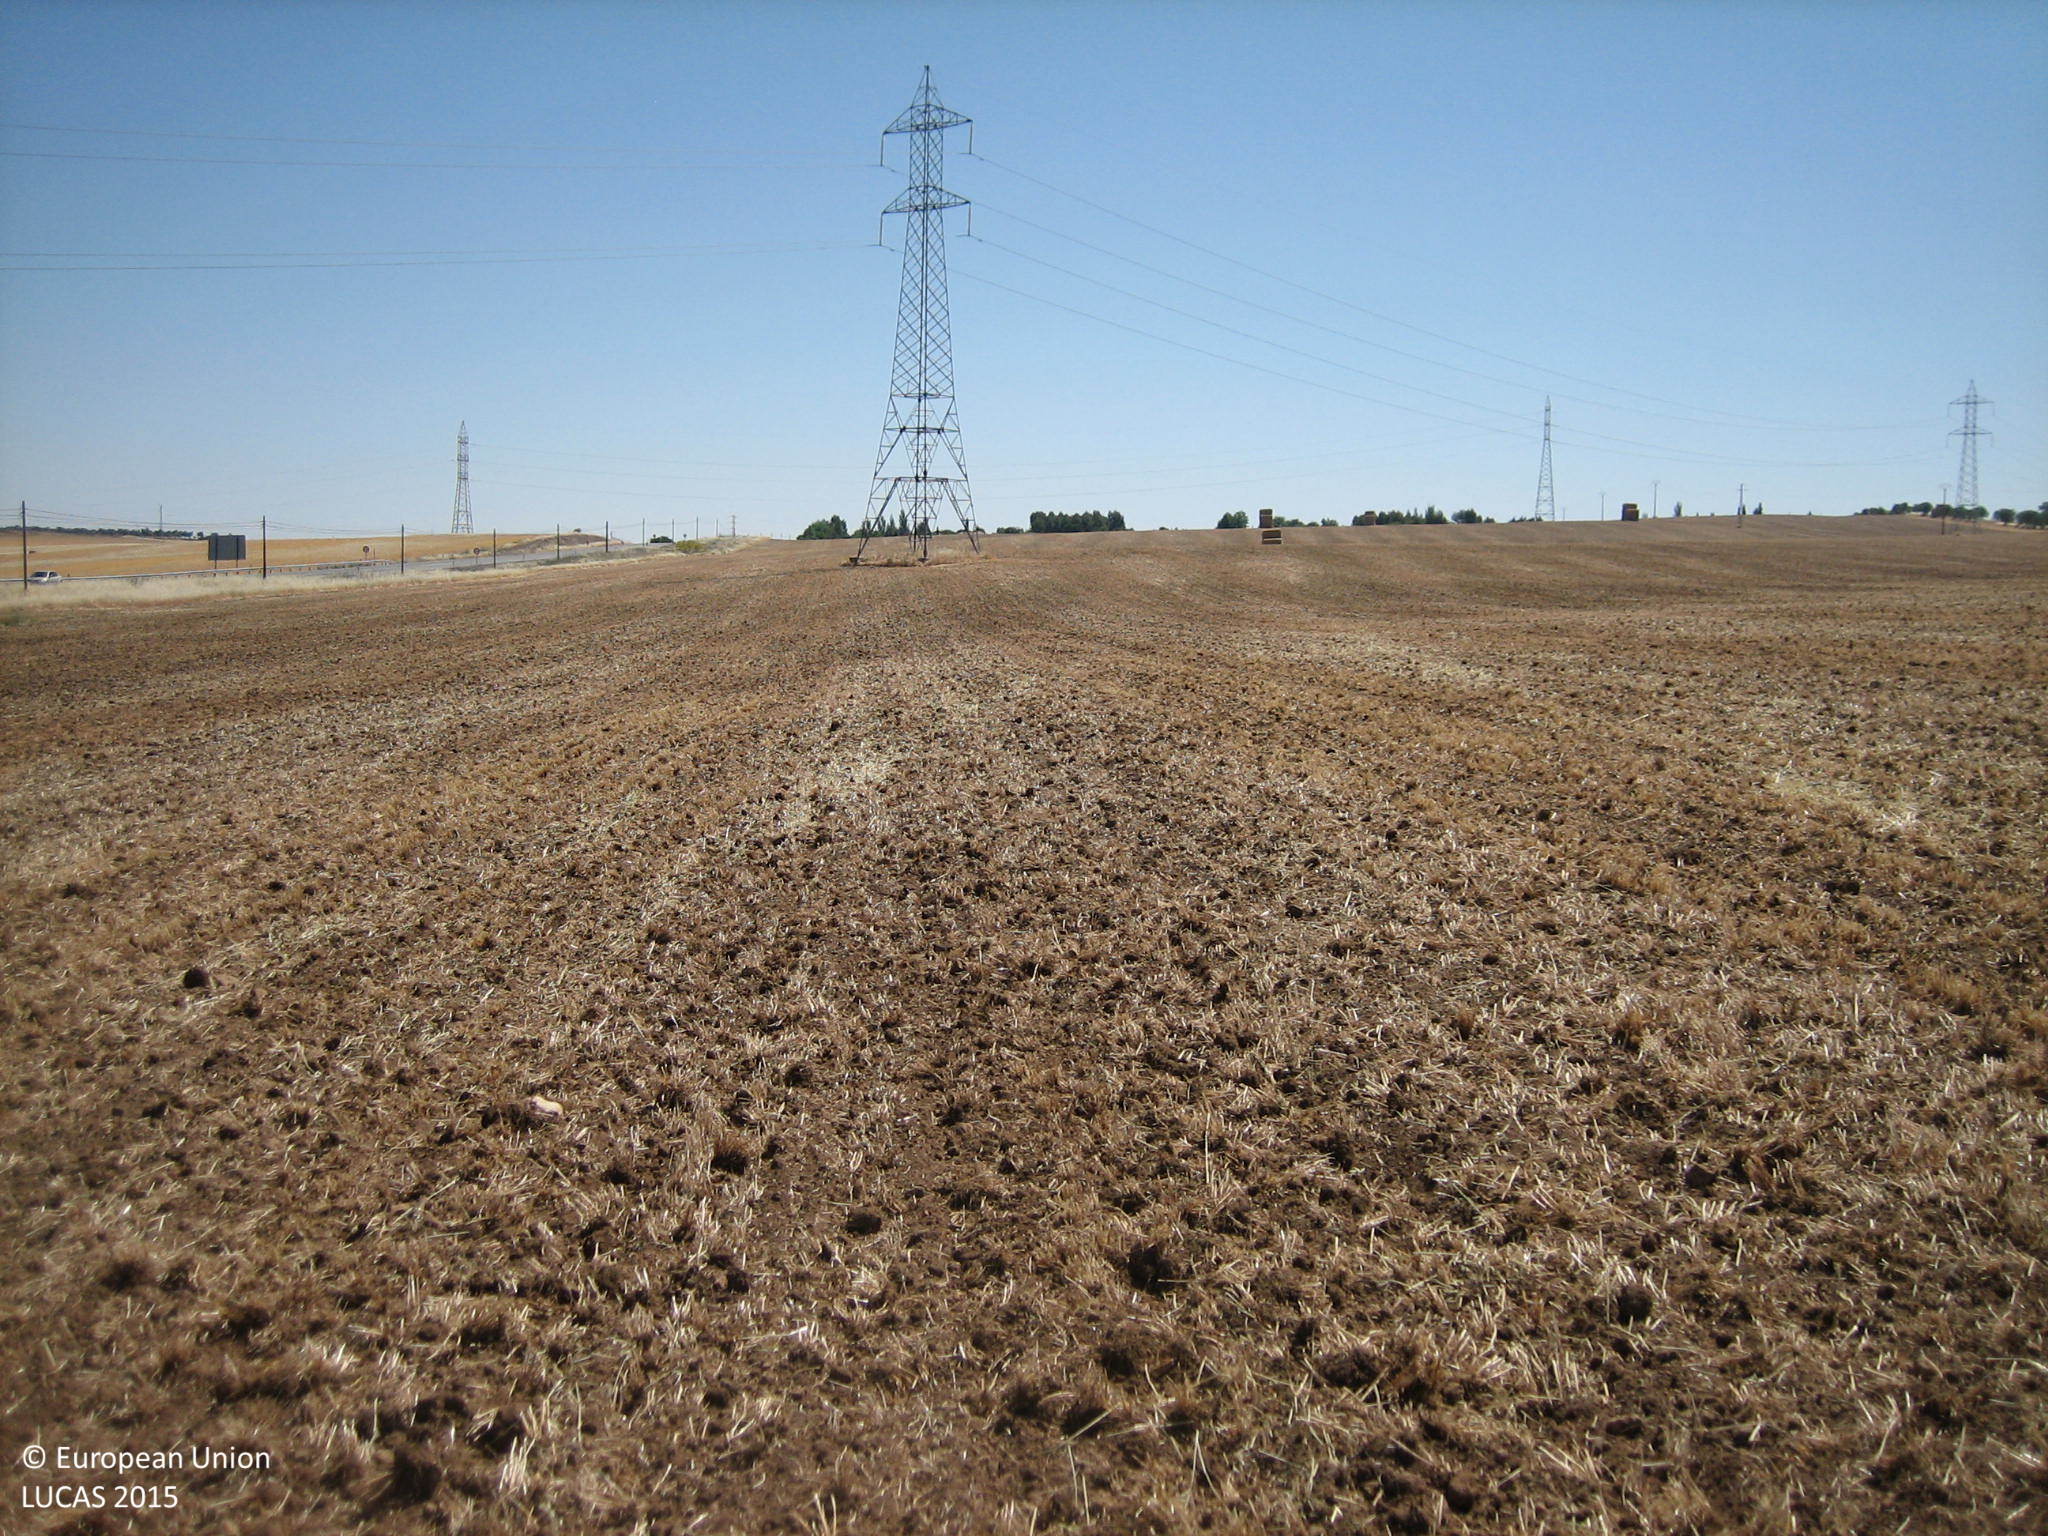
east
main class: Cropland
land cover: Oats
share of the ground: > 75 %
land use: Agriculture (excluding fallow land and kitchen gardens)
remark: Harvested field
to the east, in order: Oats
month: May
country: ES
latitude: 38.9650
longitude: -3.9972
